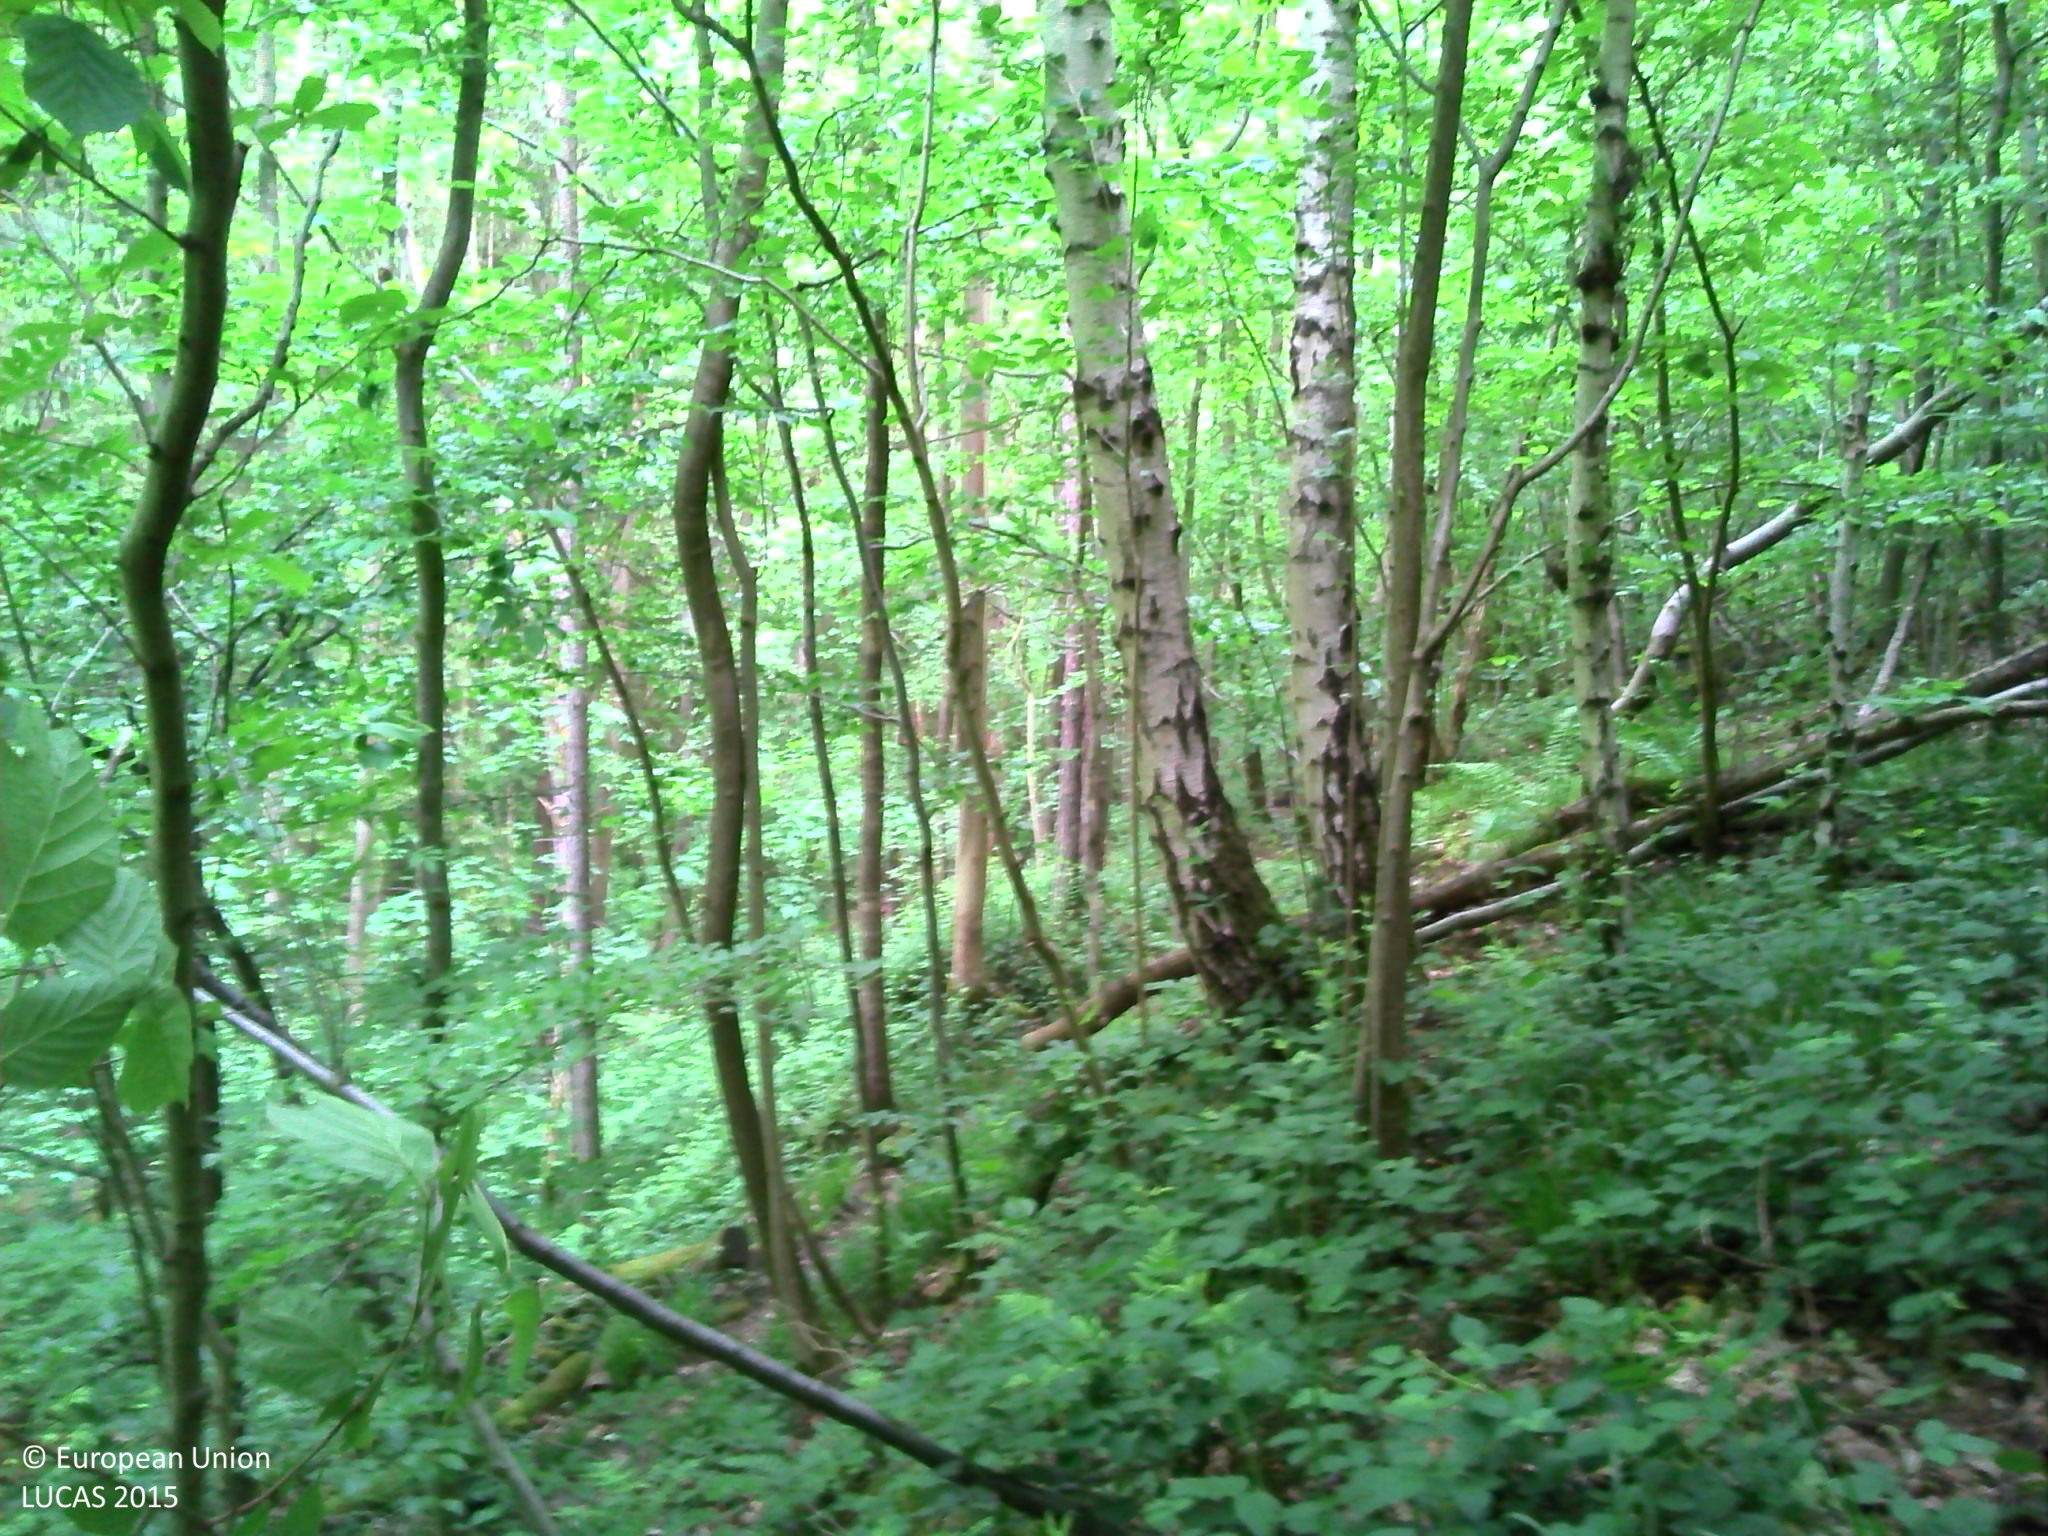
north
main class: Woodland
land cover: Broadleaved woodland
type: mesophytic deciduous forest
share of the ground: > 75 %
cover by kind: broadleaved forest trees 75 %, shrubs 20 %, coniferous forest trees 5 %
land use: Forestry
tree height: > 5 m
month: June
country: BE
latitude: 50.4947
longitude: 5.1341
